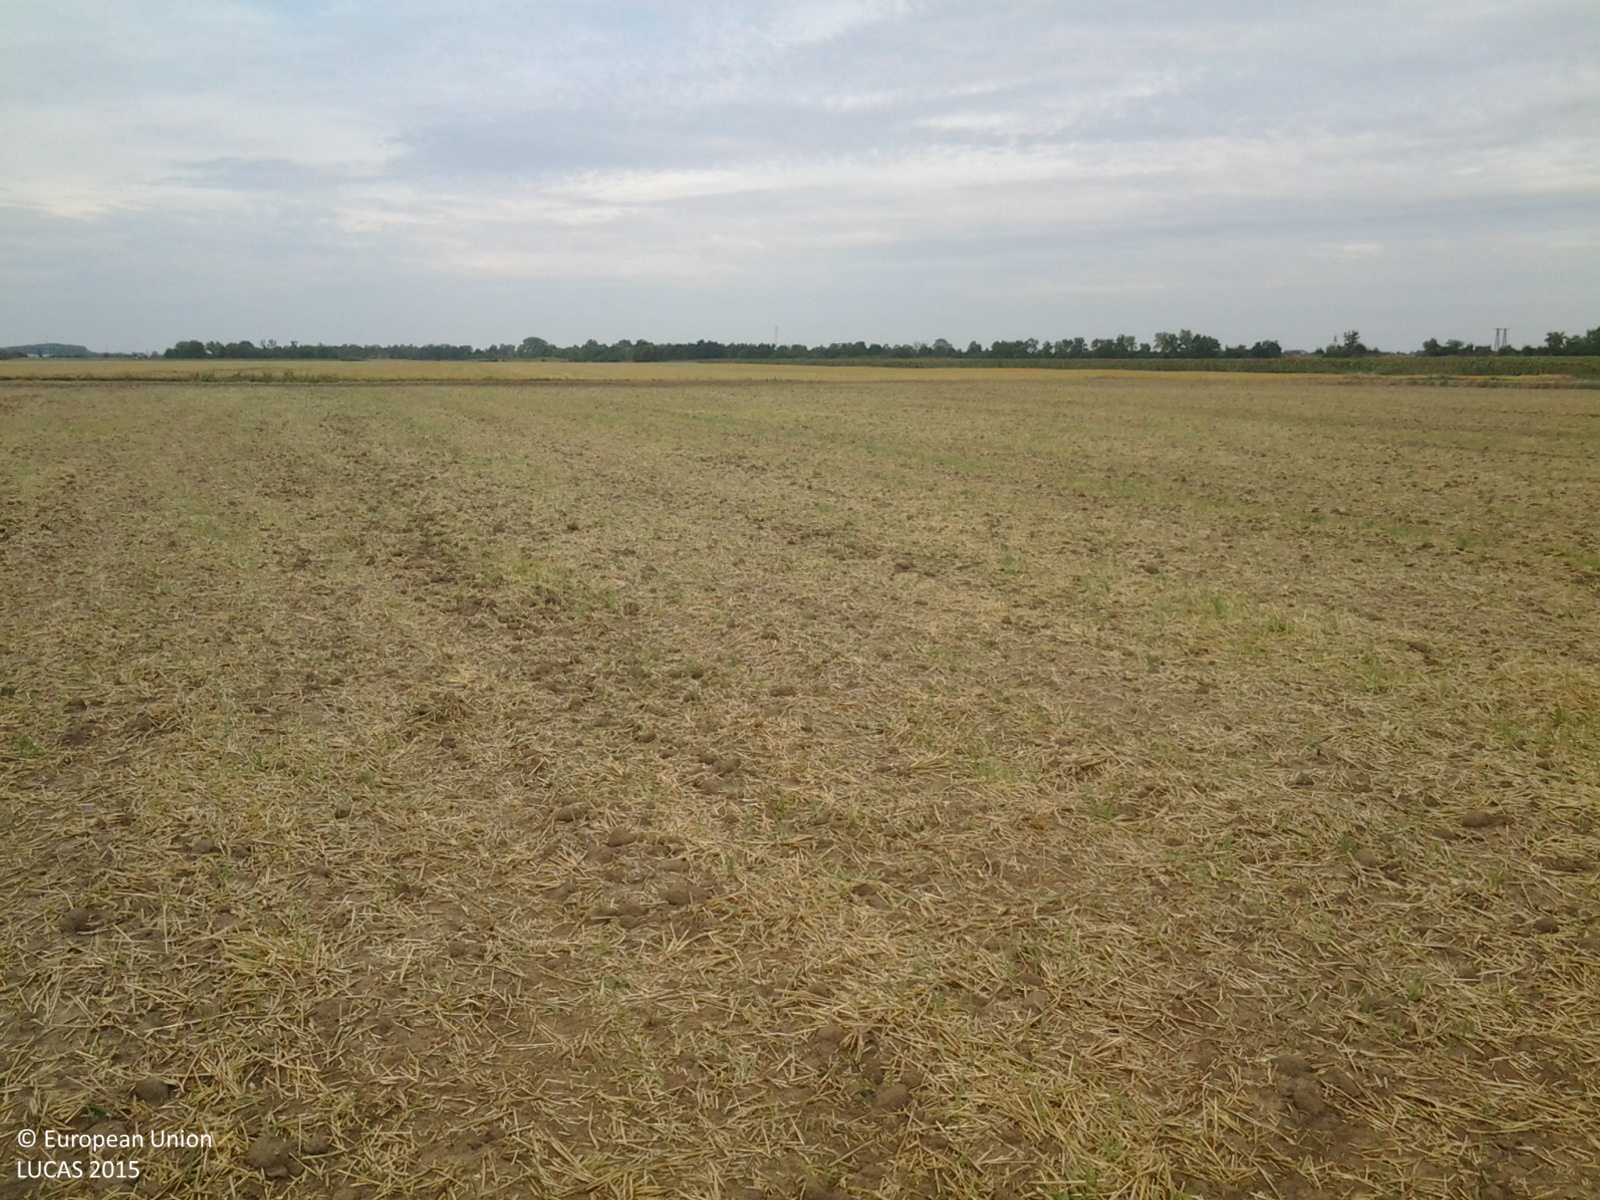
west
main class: Cropland
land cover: Common wheat
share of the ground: < 10 %
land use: Agriculture (excluding fallow land and kitchen gardens)
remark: Harvested field
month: July
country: HU
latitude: 47.1006
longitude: 21.2504
